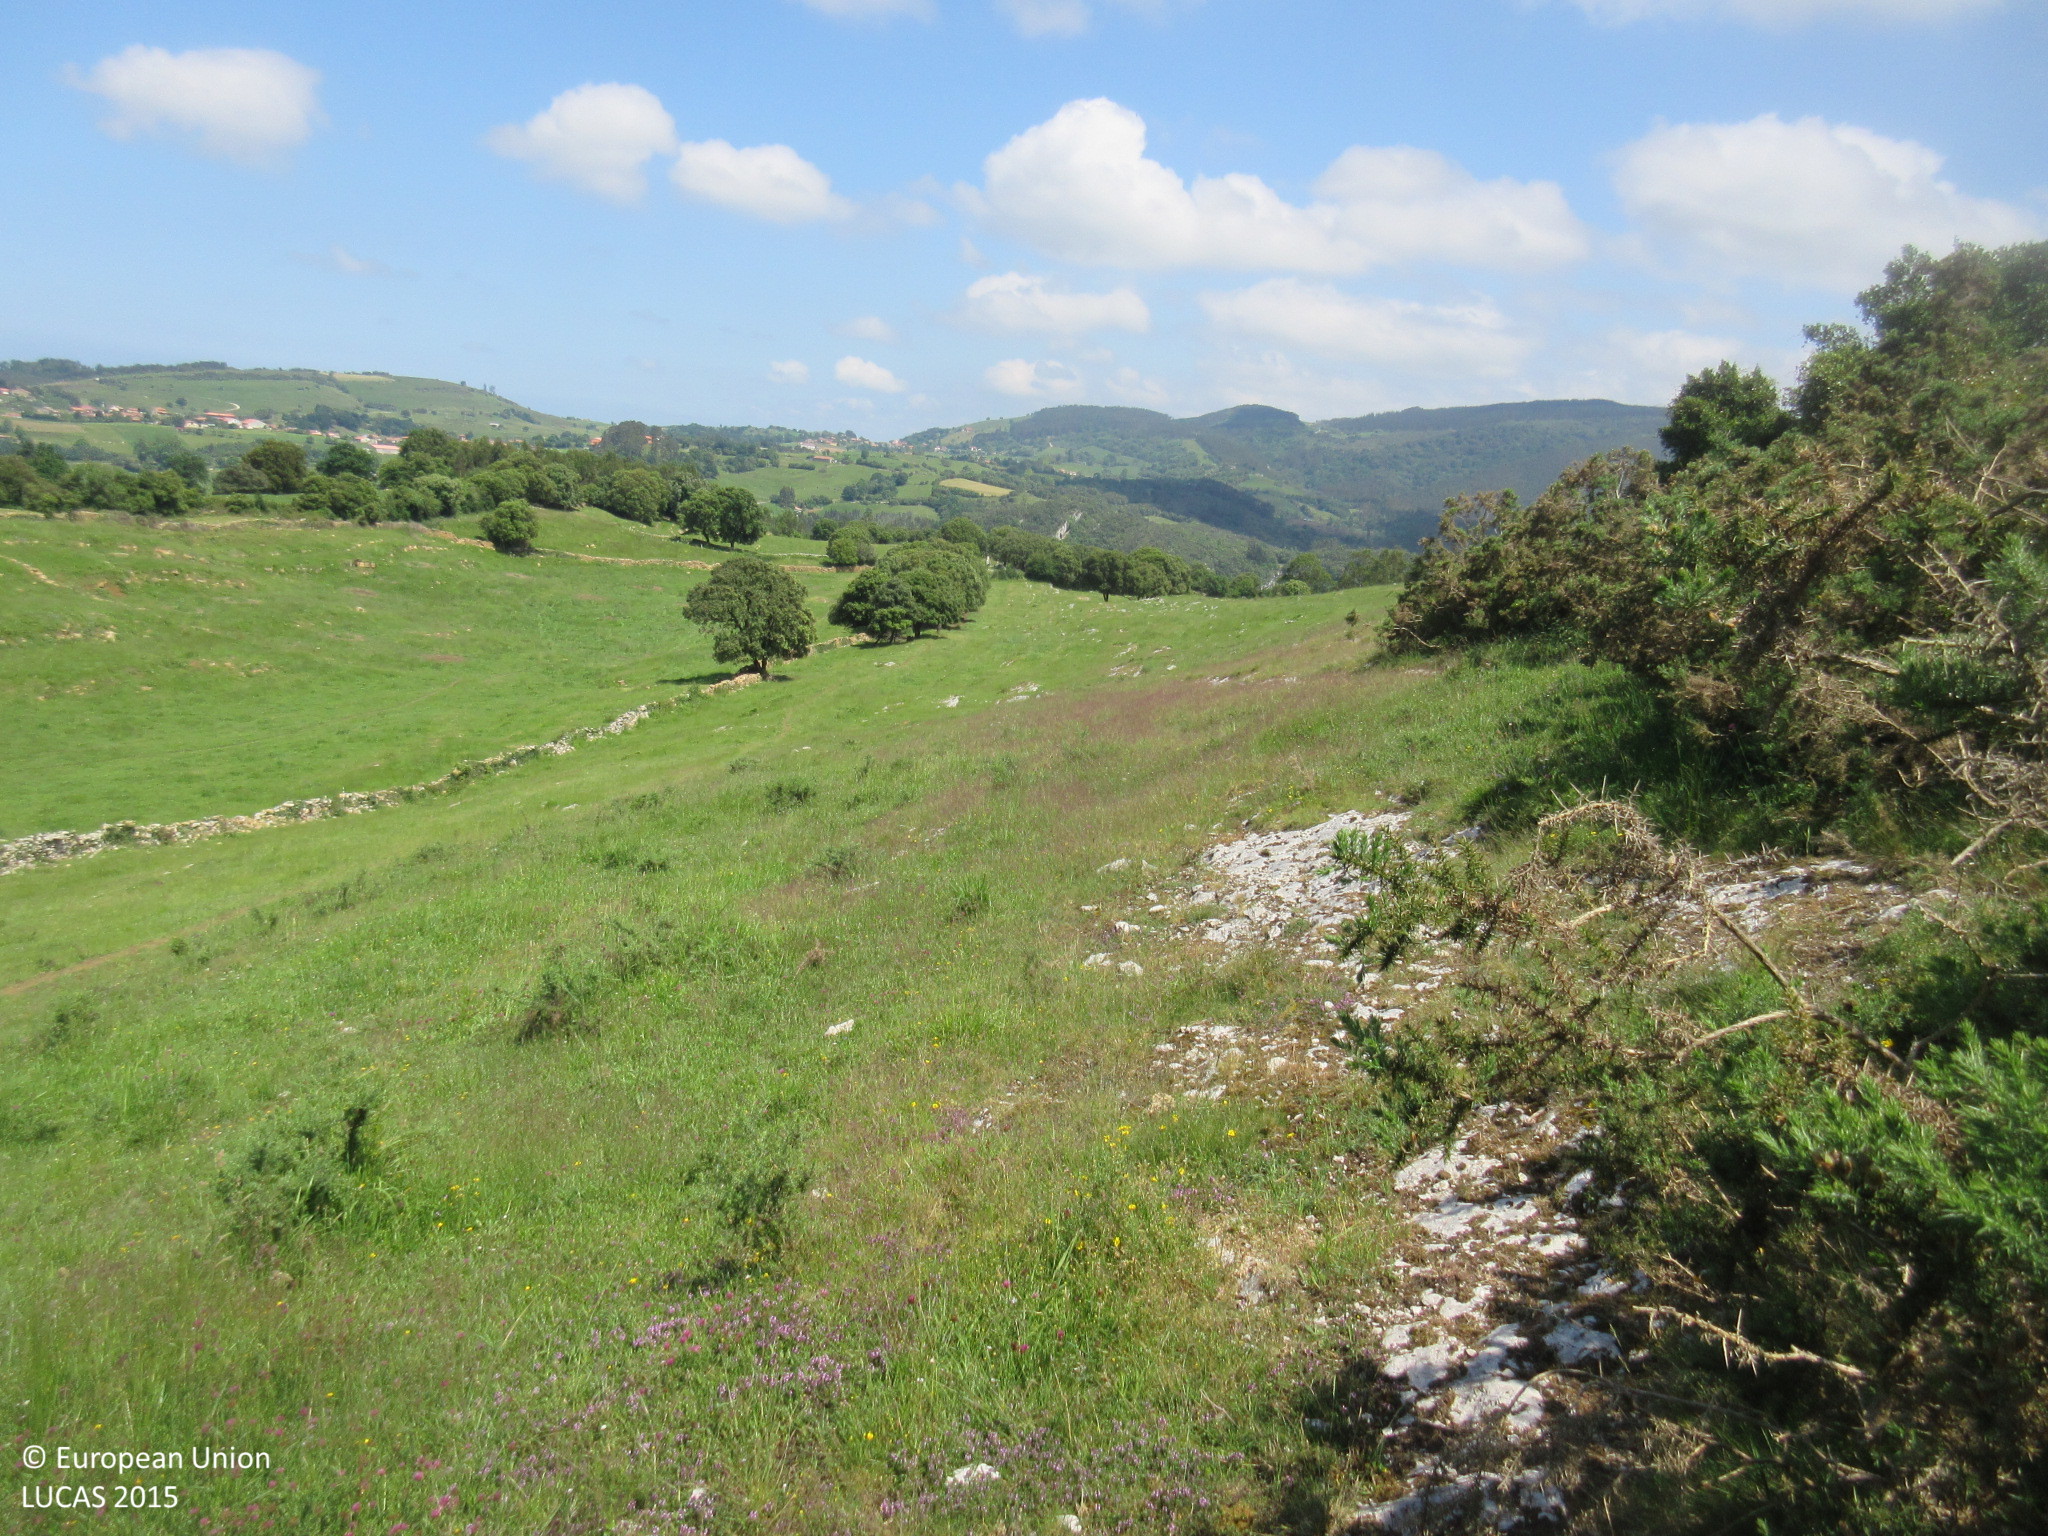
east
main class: Shrubland
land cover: Shrubland with sparse tree cover
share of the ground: > 75 %
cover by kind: shrubs 95 %, broadleaved forest trees 5 %
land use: Agriculture (excluding fallow land and kitchen gardens)
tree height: < 5 m
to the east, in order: Shrubland with sparse tree cover; Grassland without tree/shrub cover
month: May
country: ES
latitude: 43.3433
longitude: -4.5052
